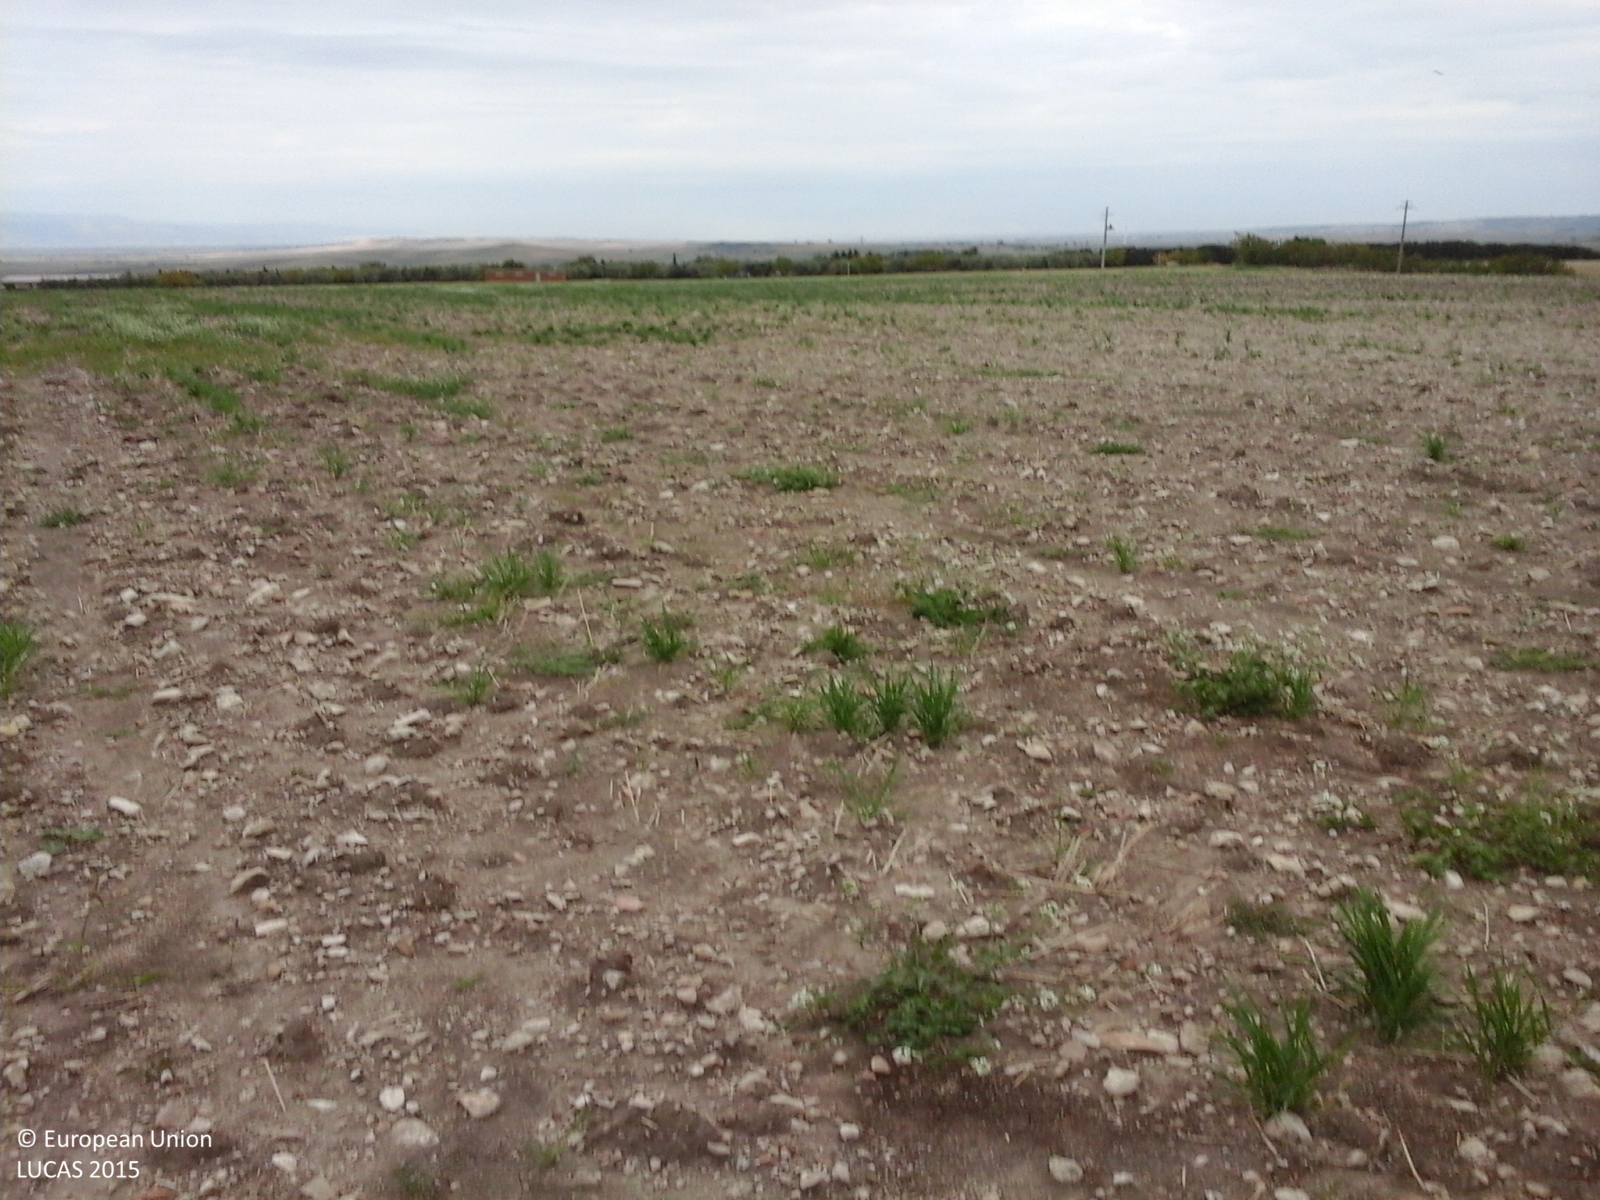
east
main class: Cropland
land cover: Durum wheat
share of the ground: > 75 %
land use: Agriculture (excluding fallow land and kitchen gardens)
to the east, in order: Durum wheat
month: October
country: IT
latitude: 41.5611
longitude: 15.1988
